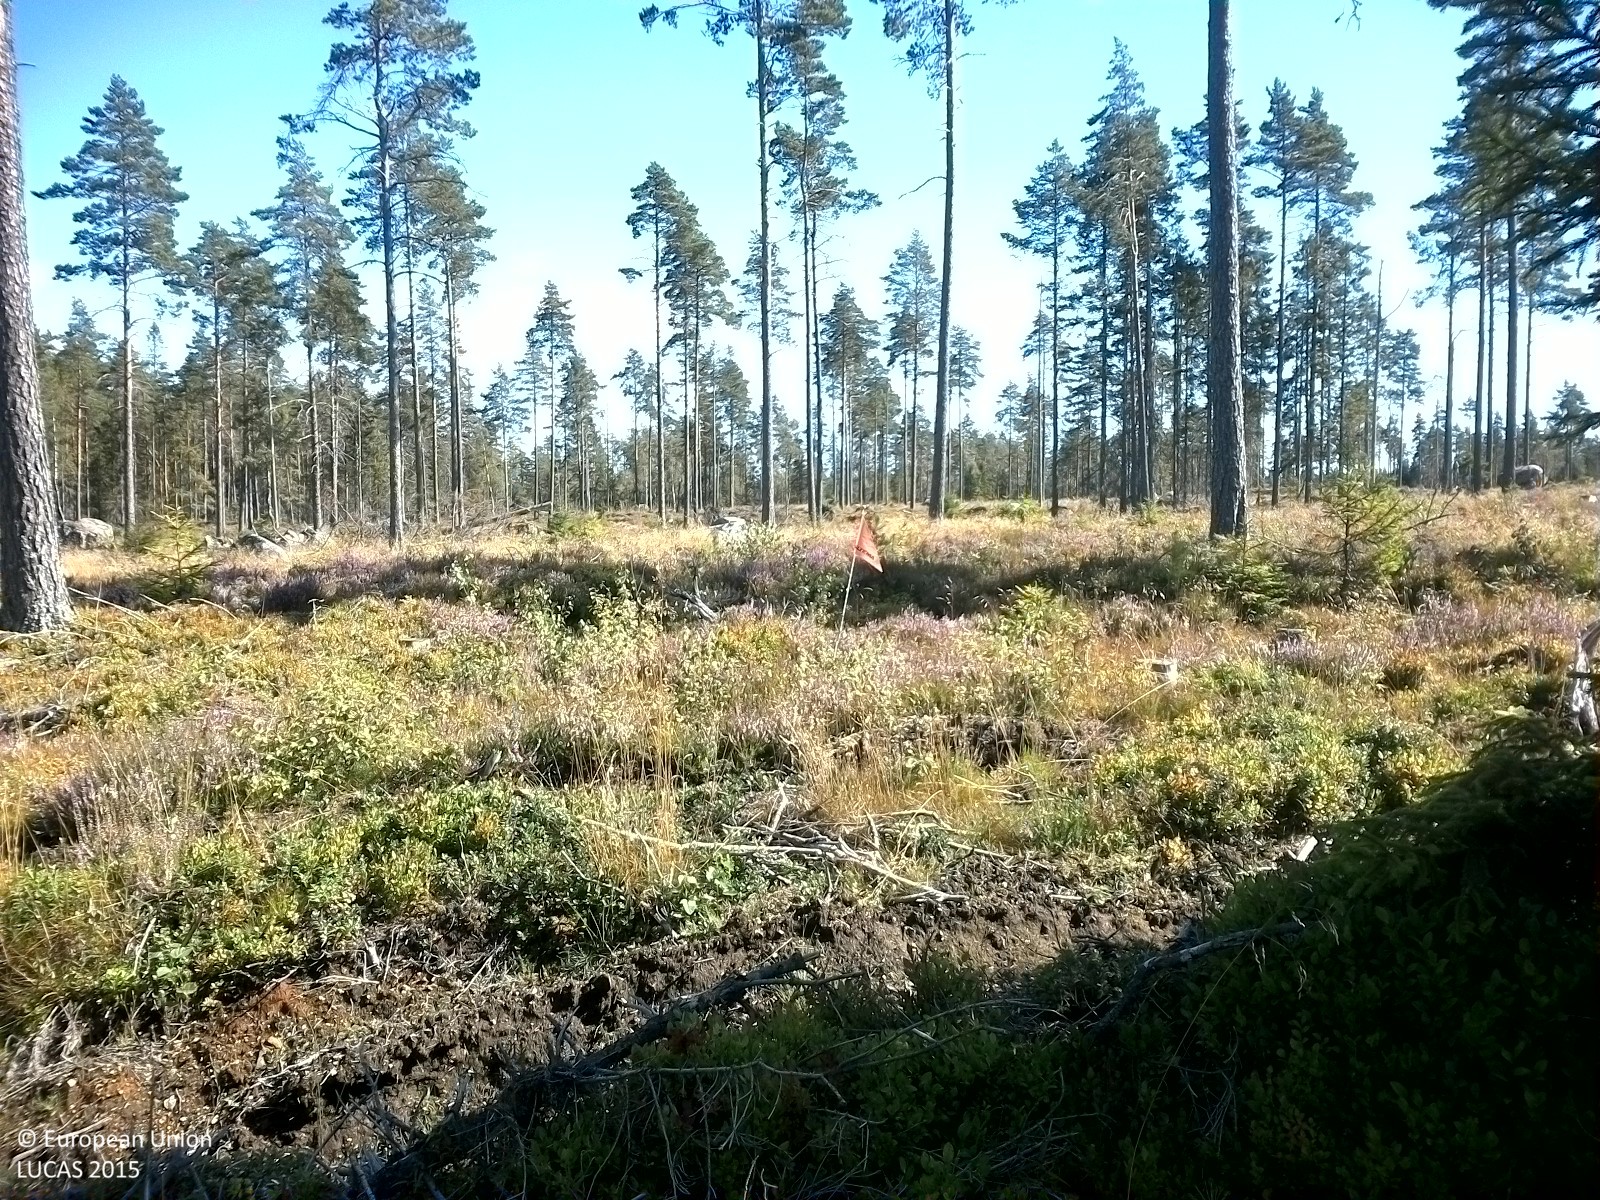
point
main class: Woodland
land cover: Pine dominated coniferous woodland
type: boreal forest
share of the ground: 10 - 25 %
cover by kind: shrubs 45 %, herbaceous plants 25 %, coniferous forest trees 15 %, lichens and mosses 15 %
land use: Forestry
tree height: > 5 m
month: August
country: SE
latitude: 59.4173
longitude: 14.6960
